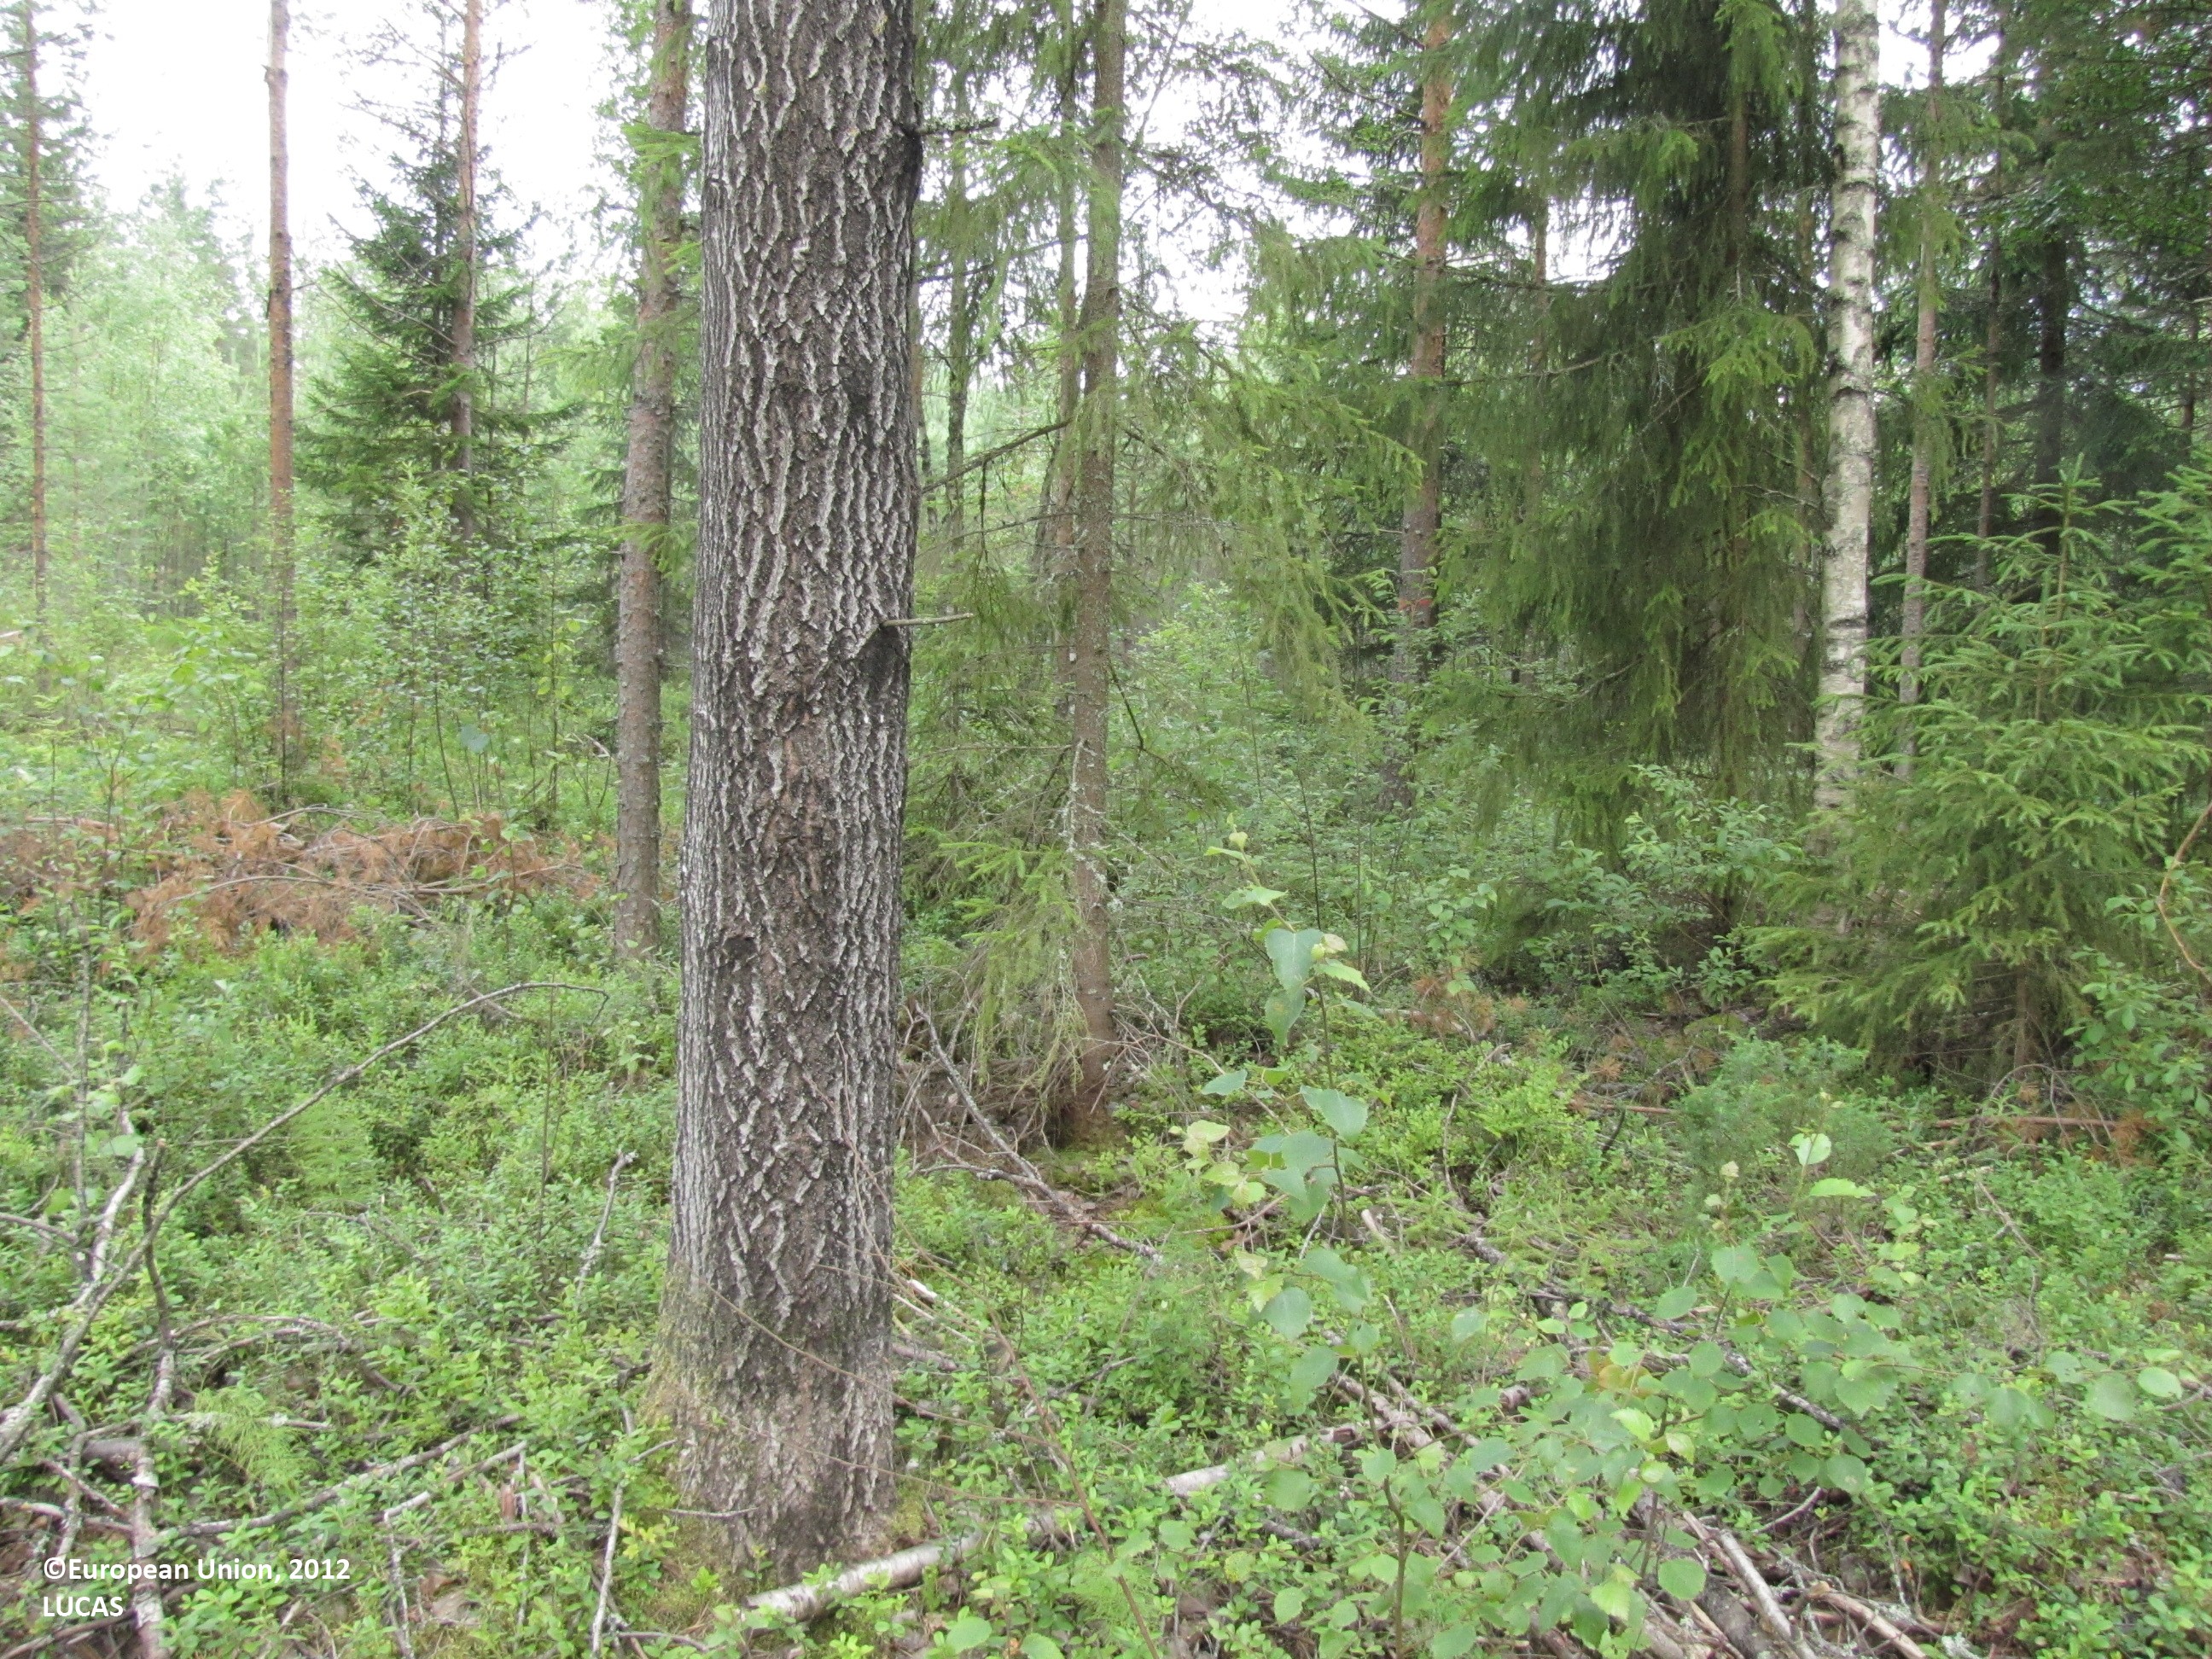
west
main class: Woodland
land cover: Pine dominated coniferous woodland
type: boreal forest
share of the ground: 50 - 75 %
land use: Forestry
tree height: > 5 m
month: July
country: FI
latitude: 62.6347
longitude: 23.3868
